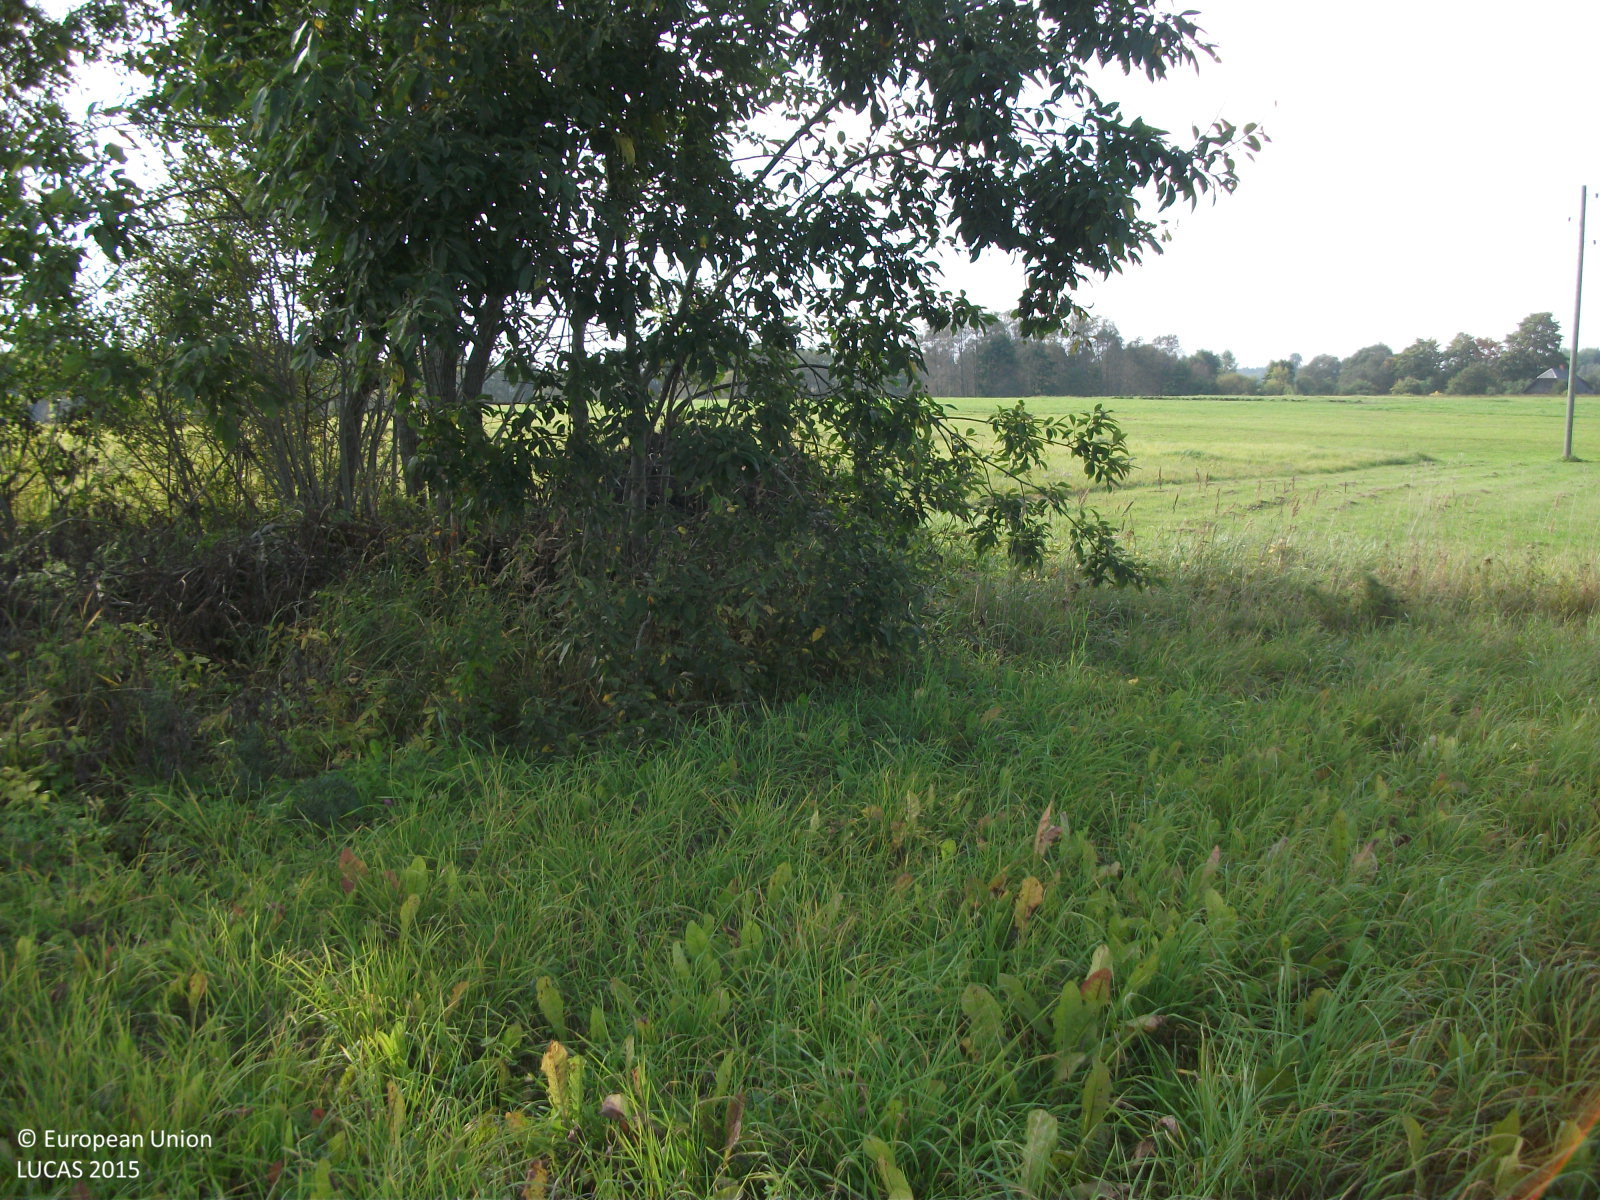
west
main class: Grassland
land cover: Grassland without tree/shrub cover
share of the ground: > 75 %
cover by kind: herbaceous plants 100 %
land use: Agriculture (excluding fallow land and kitchen gardens)
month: September
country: LV
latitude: 57.7774
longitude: 24.8097
